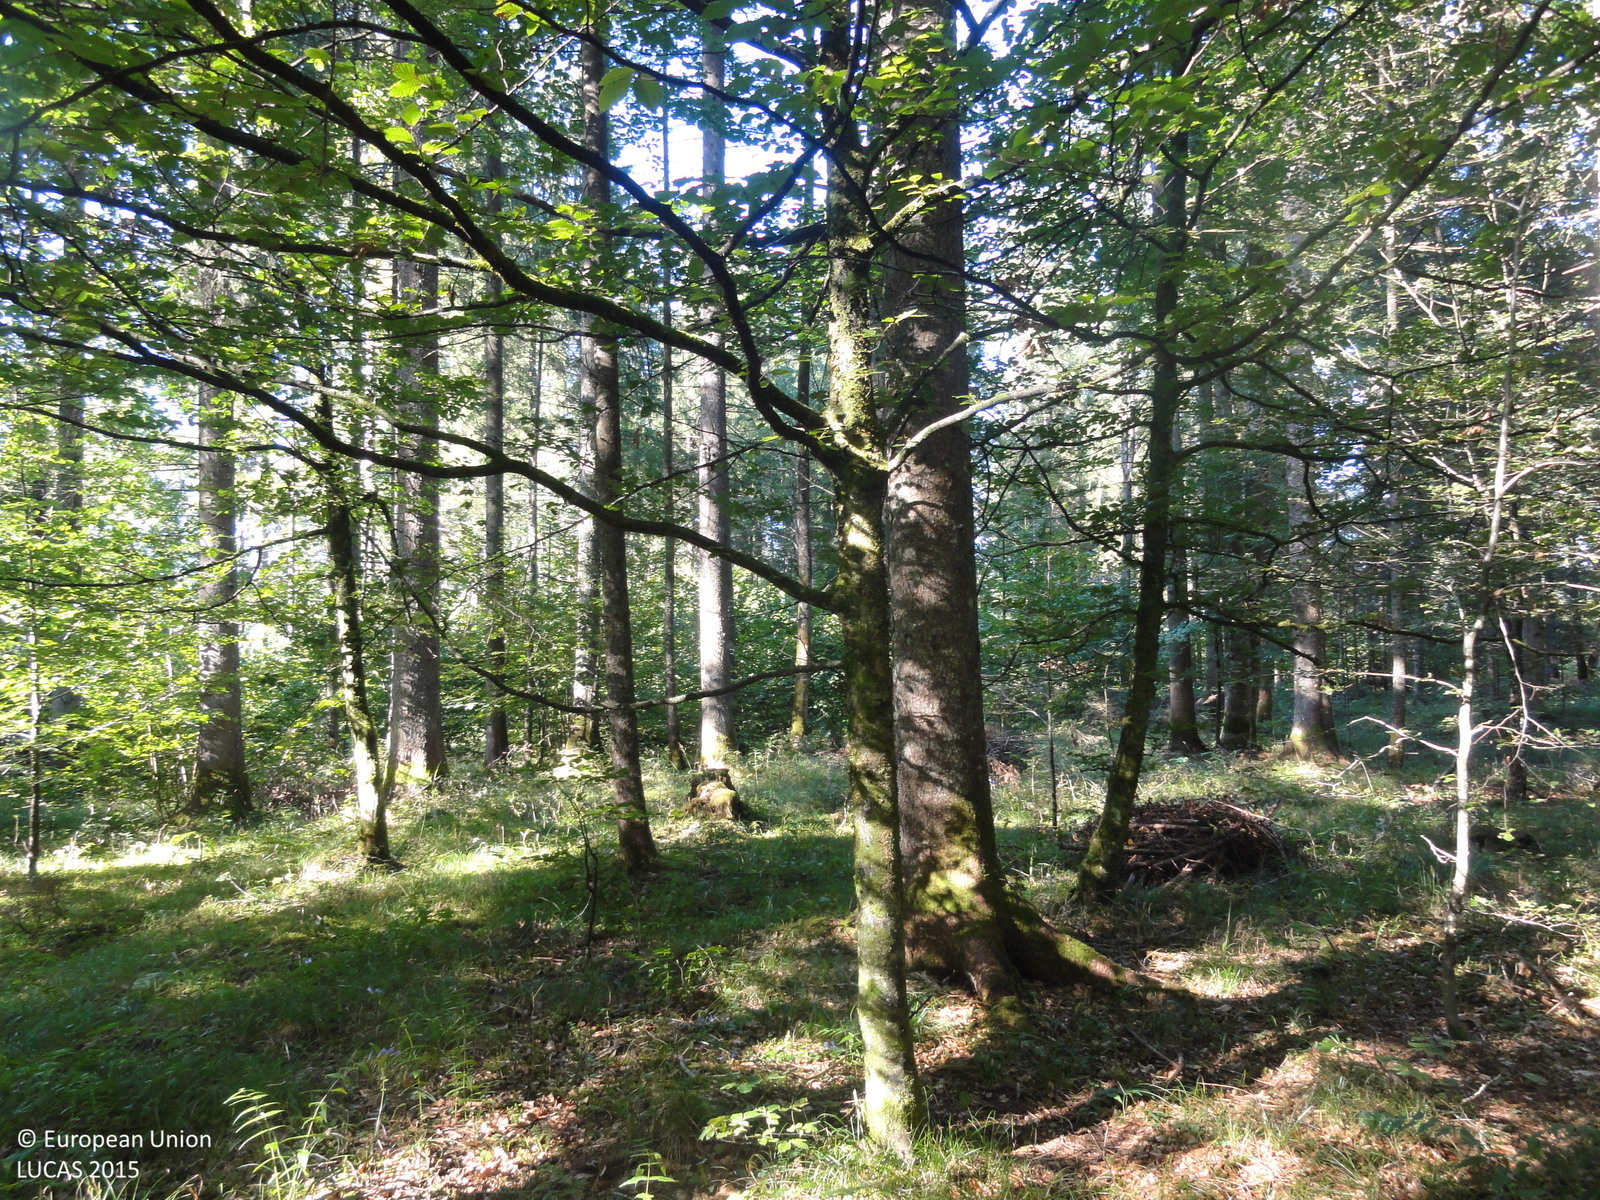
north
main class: Woodland
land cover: Spruce dominated mixed woodland
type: mountainous beech forest
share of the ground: > 75 %
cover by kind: coniferous forest trees 55 %, broadleaved forest trees 30 %, herbaceous plants 10 %, unconsolidated bare surface 5 %
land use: Forestry
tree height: > 5 m
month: September
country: SI
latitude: 45.6836
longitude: 14.8107
